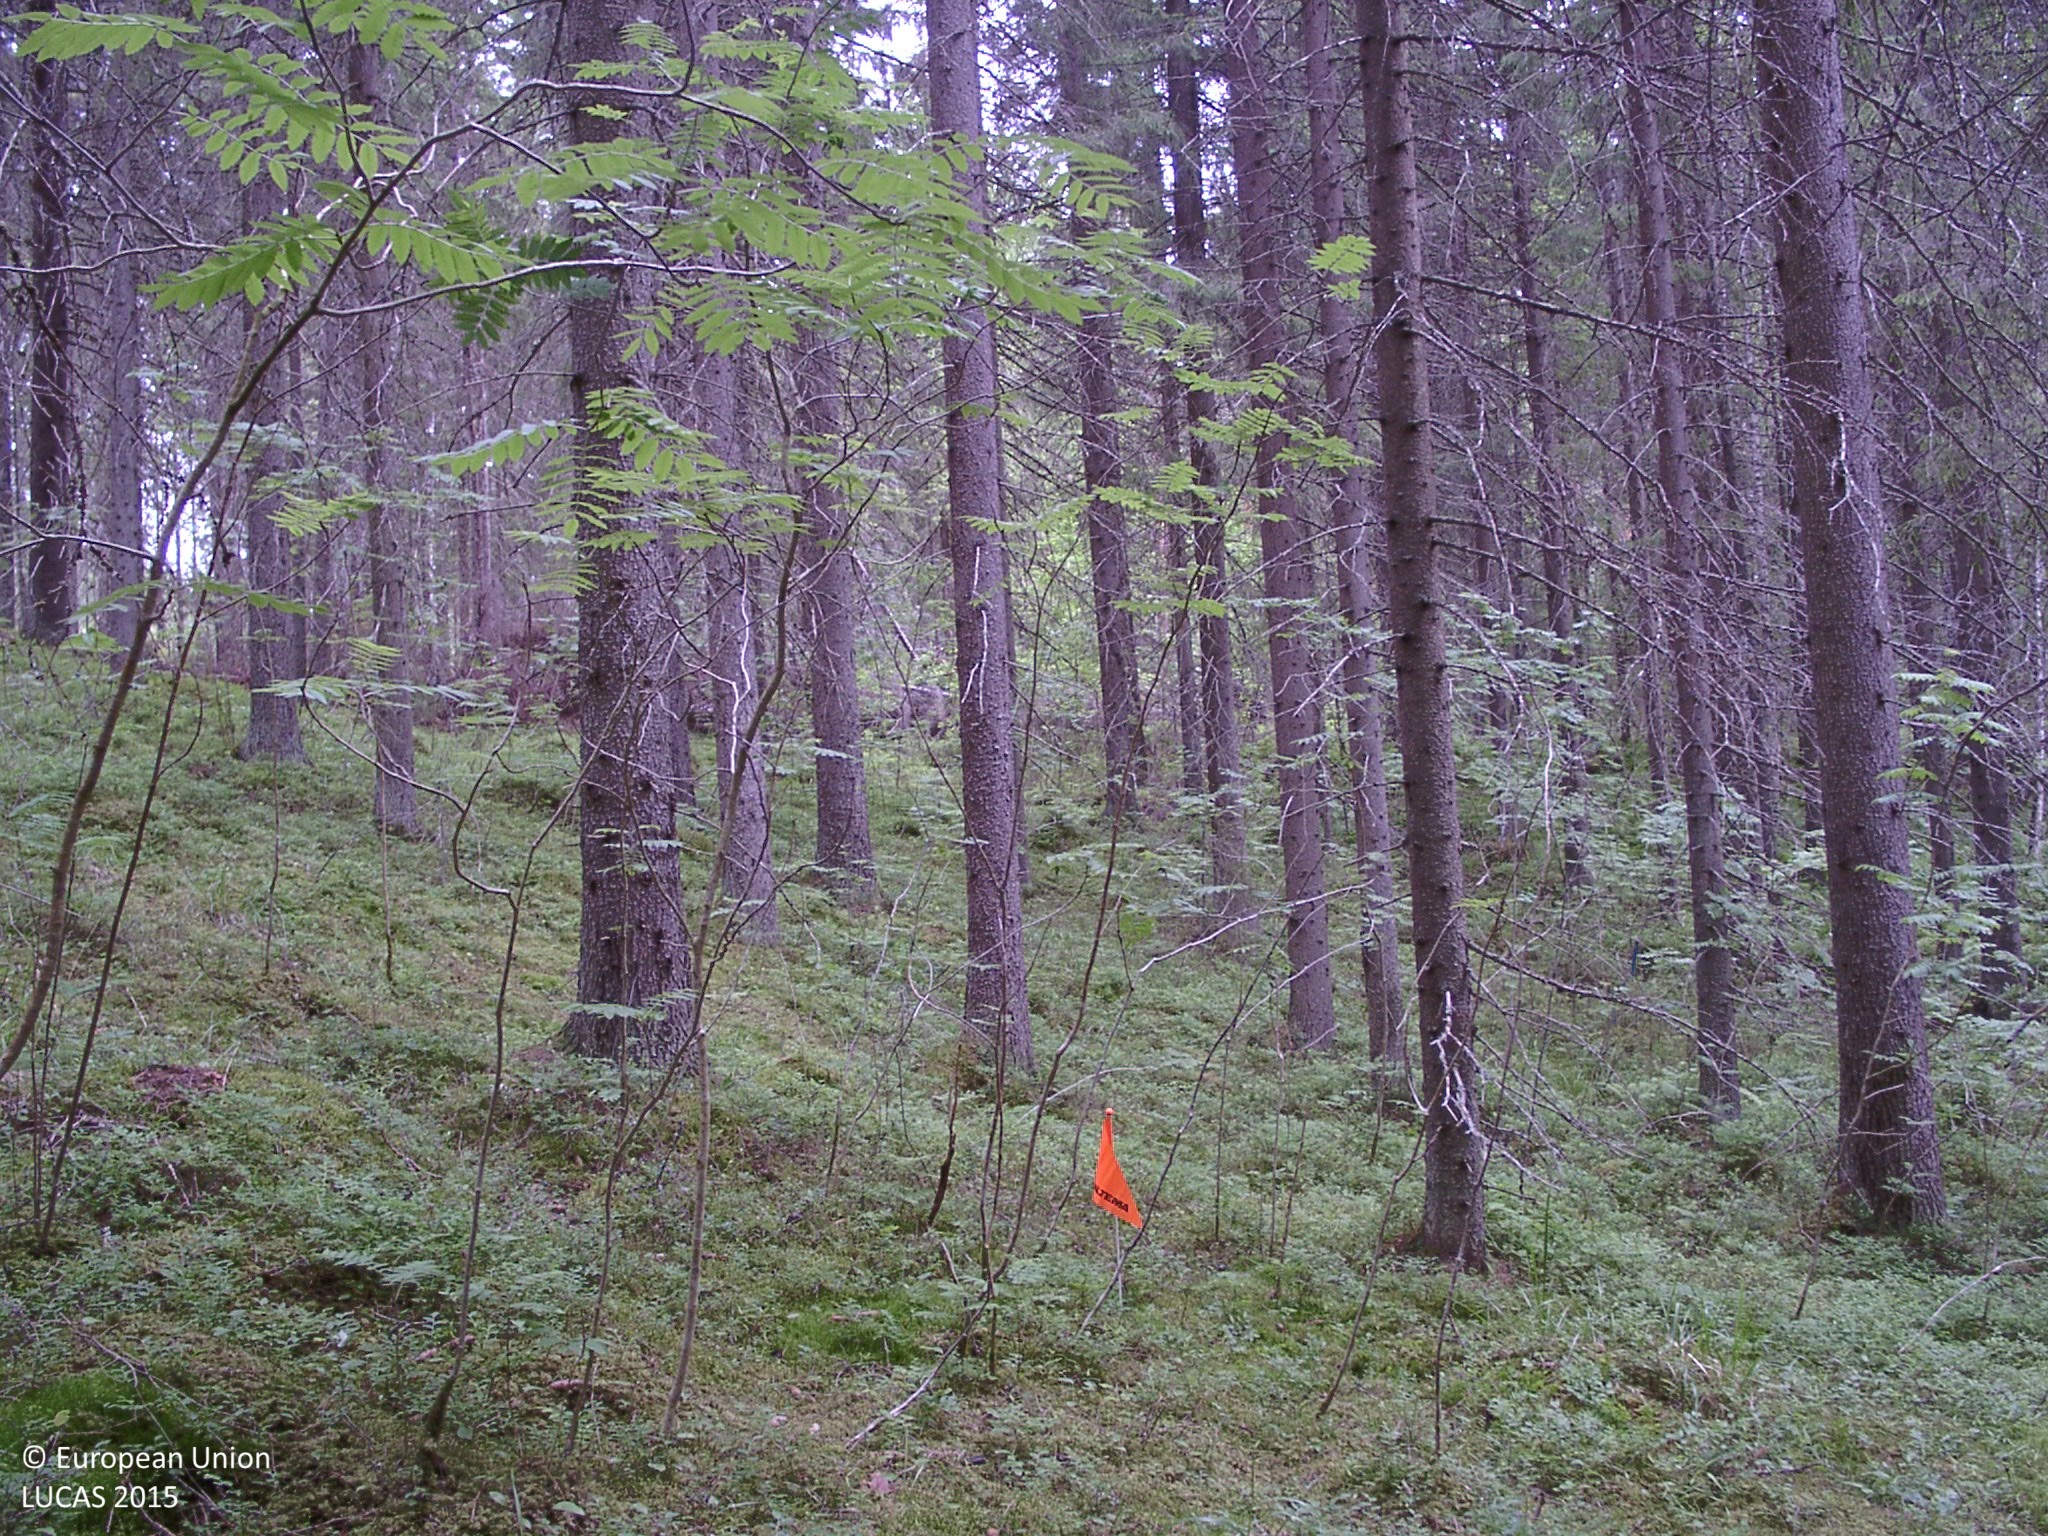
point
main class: Woodland
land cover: Spruce dominated coniferous woodland
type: boreal forest
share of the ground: 50 - 75 %
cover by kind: coniferous forest trees 60 %, shrubs 20 %, broadleaved forest trees 10 %, lichens and mosses 10 %
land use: Forestry
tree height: > 5 m
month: July
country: FI
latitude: 61.9907
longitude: 25.2865
